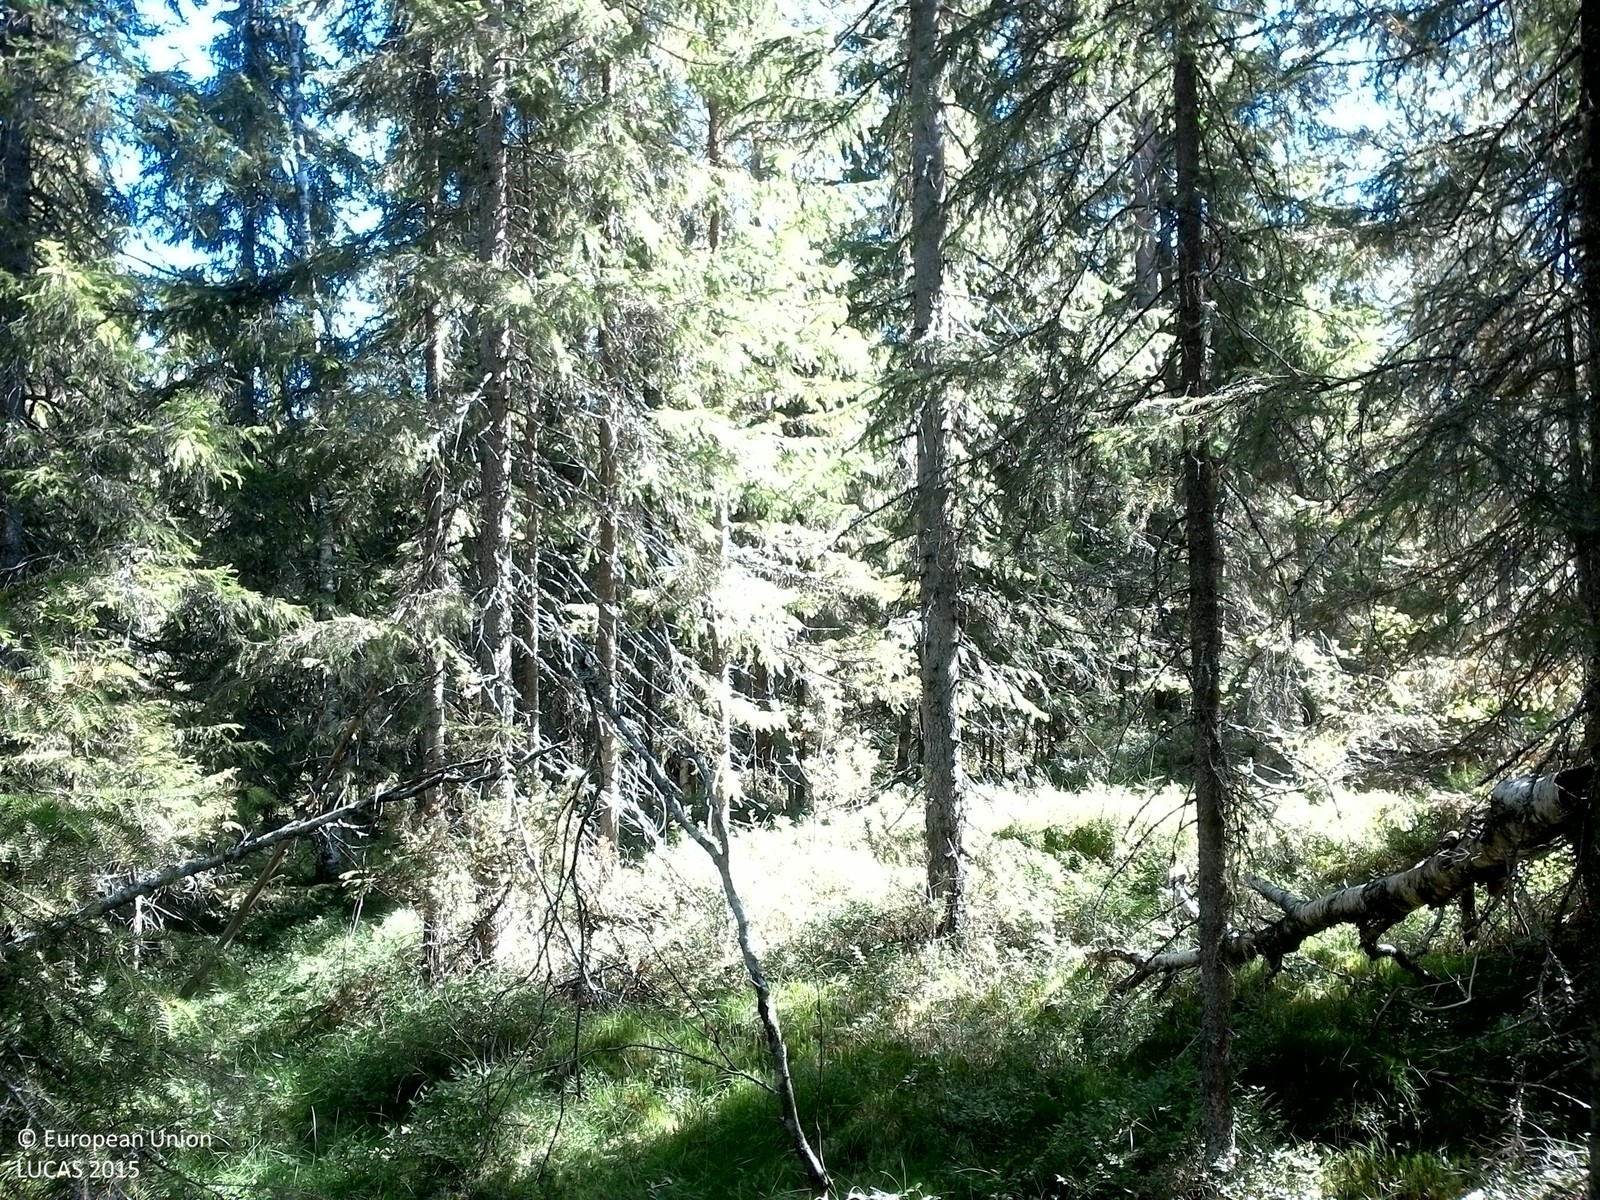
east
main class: Woodland
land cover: Spruce dominated coniferous woodland
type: boreal forest
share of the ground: > 75 %
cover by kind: coniferous forest trees 70 %, broadleaved forest trees 10 %, shrubs 10 %, lichens and mosses 10 %
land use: Forestry
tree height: > 5 m
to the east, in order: Spruce dominated coniferous woodland
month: August
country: SE
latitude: 63.6481
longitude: 17.7069
